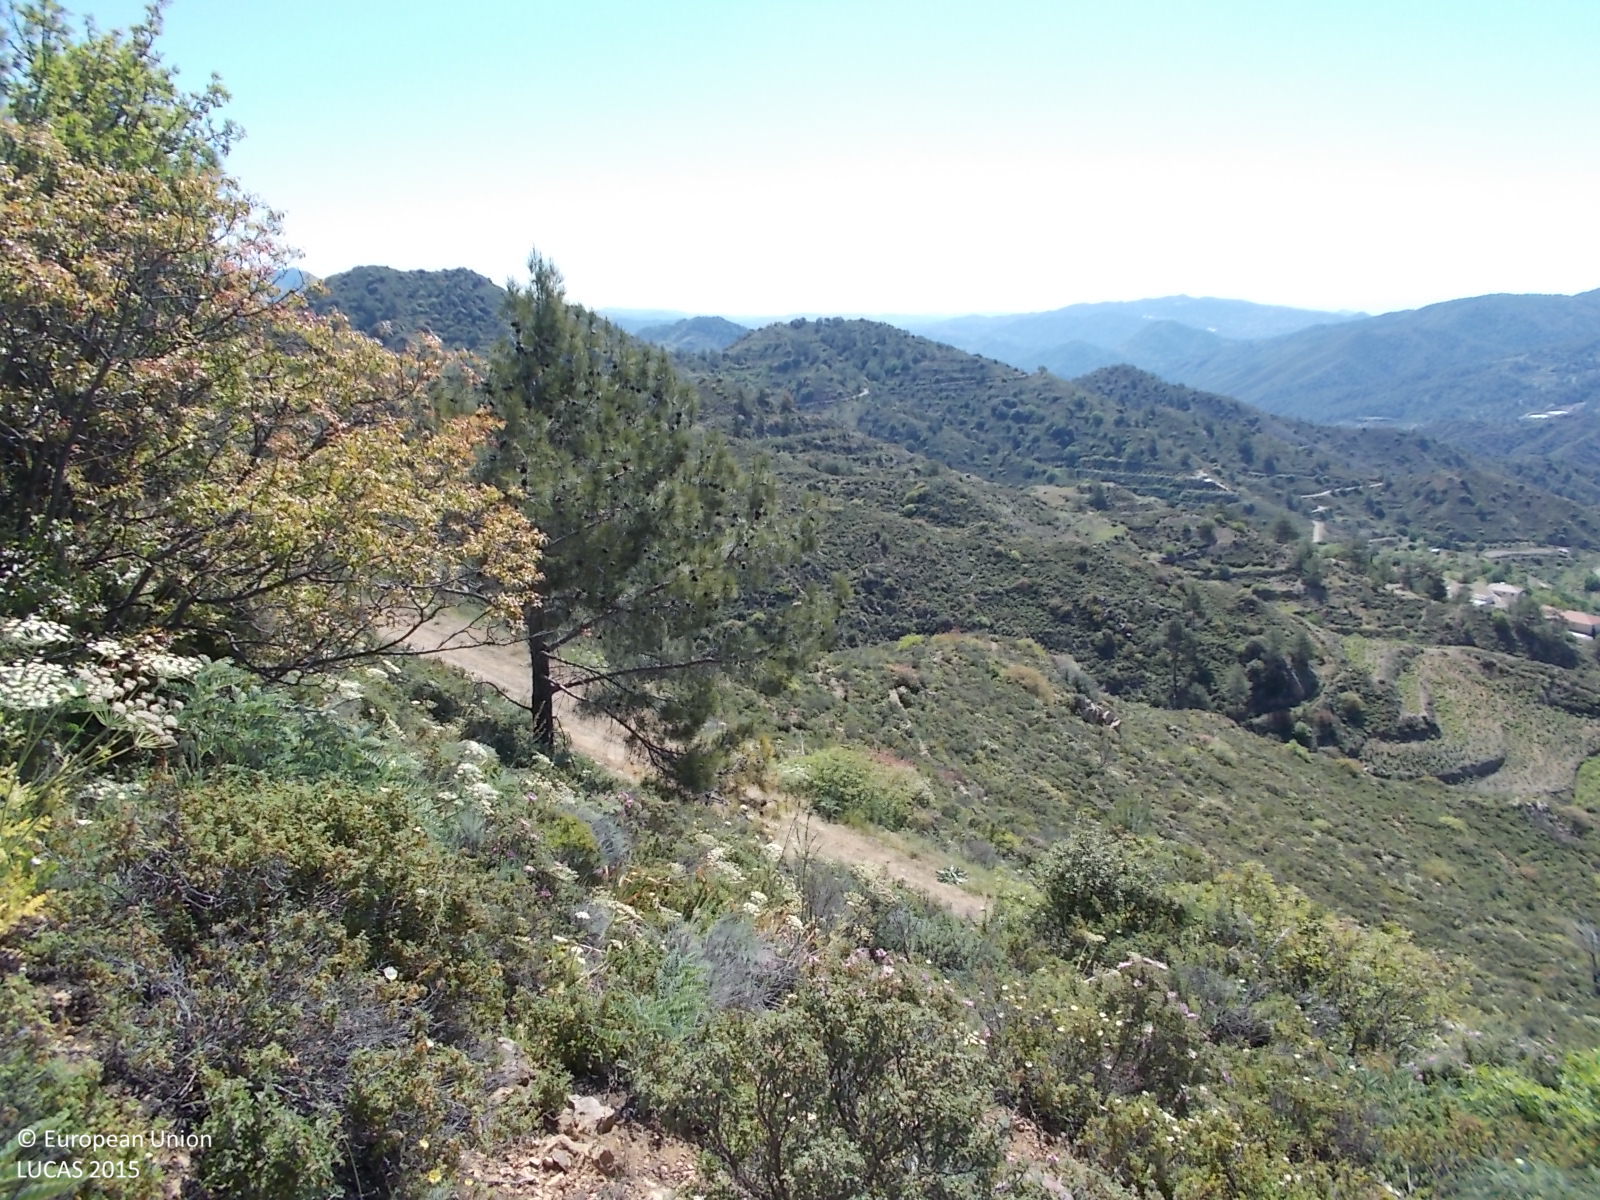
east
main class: Shrubland
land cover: Shrubland with sparse tree cover
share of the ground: > 75 %
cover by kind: shrubs 95 %, broadleaved forest trees 5 %
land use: Semi-natural and natural areas not in use
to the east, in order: Shrubland with sparse tree cover; Tracks; Shrubland without tree cover; Shrubland with sparse tree cover; Shrubland without tree cover
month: May
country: CY
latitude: 34.8636
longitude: 33.0209
